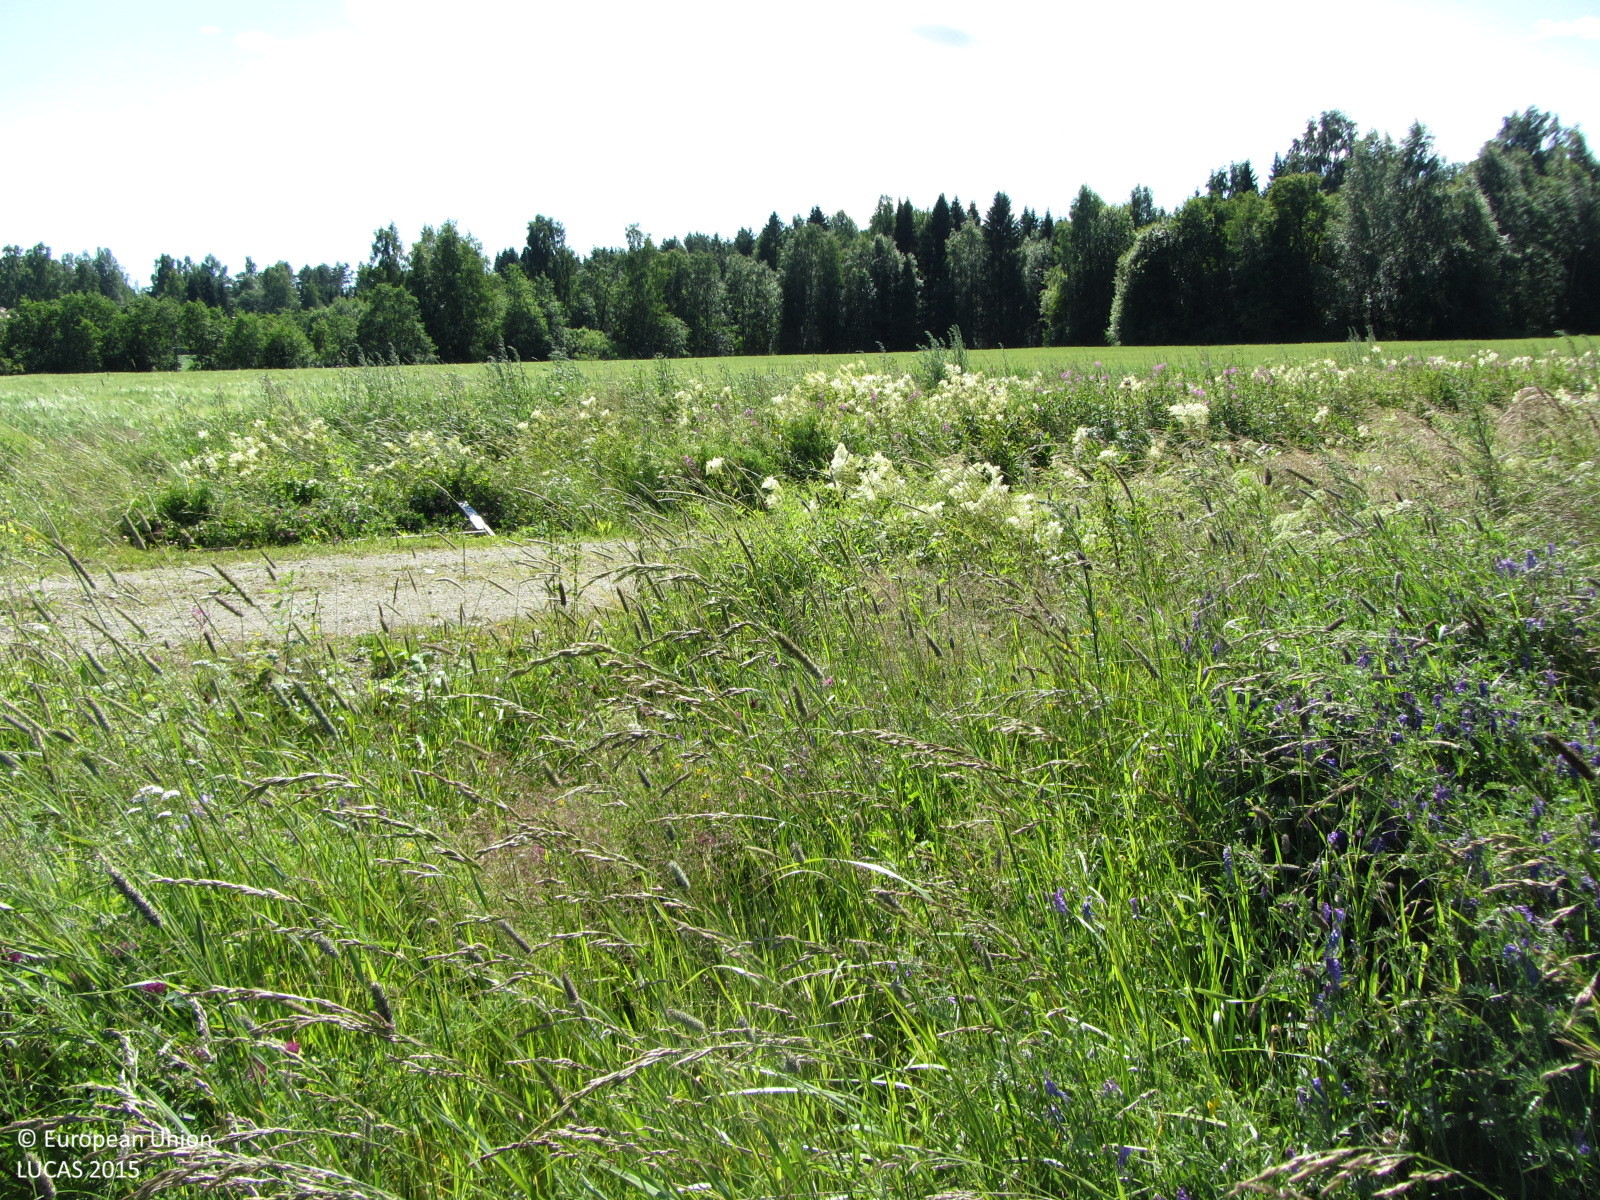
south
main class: Cropland
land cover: Temporary grasslands
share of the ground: > 75 %
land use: Agriculture (excluding fallow land and kitchen gardens)
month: July
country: FI
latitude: 61.3253
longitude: 25.3065
